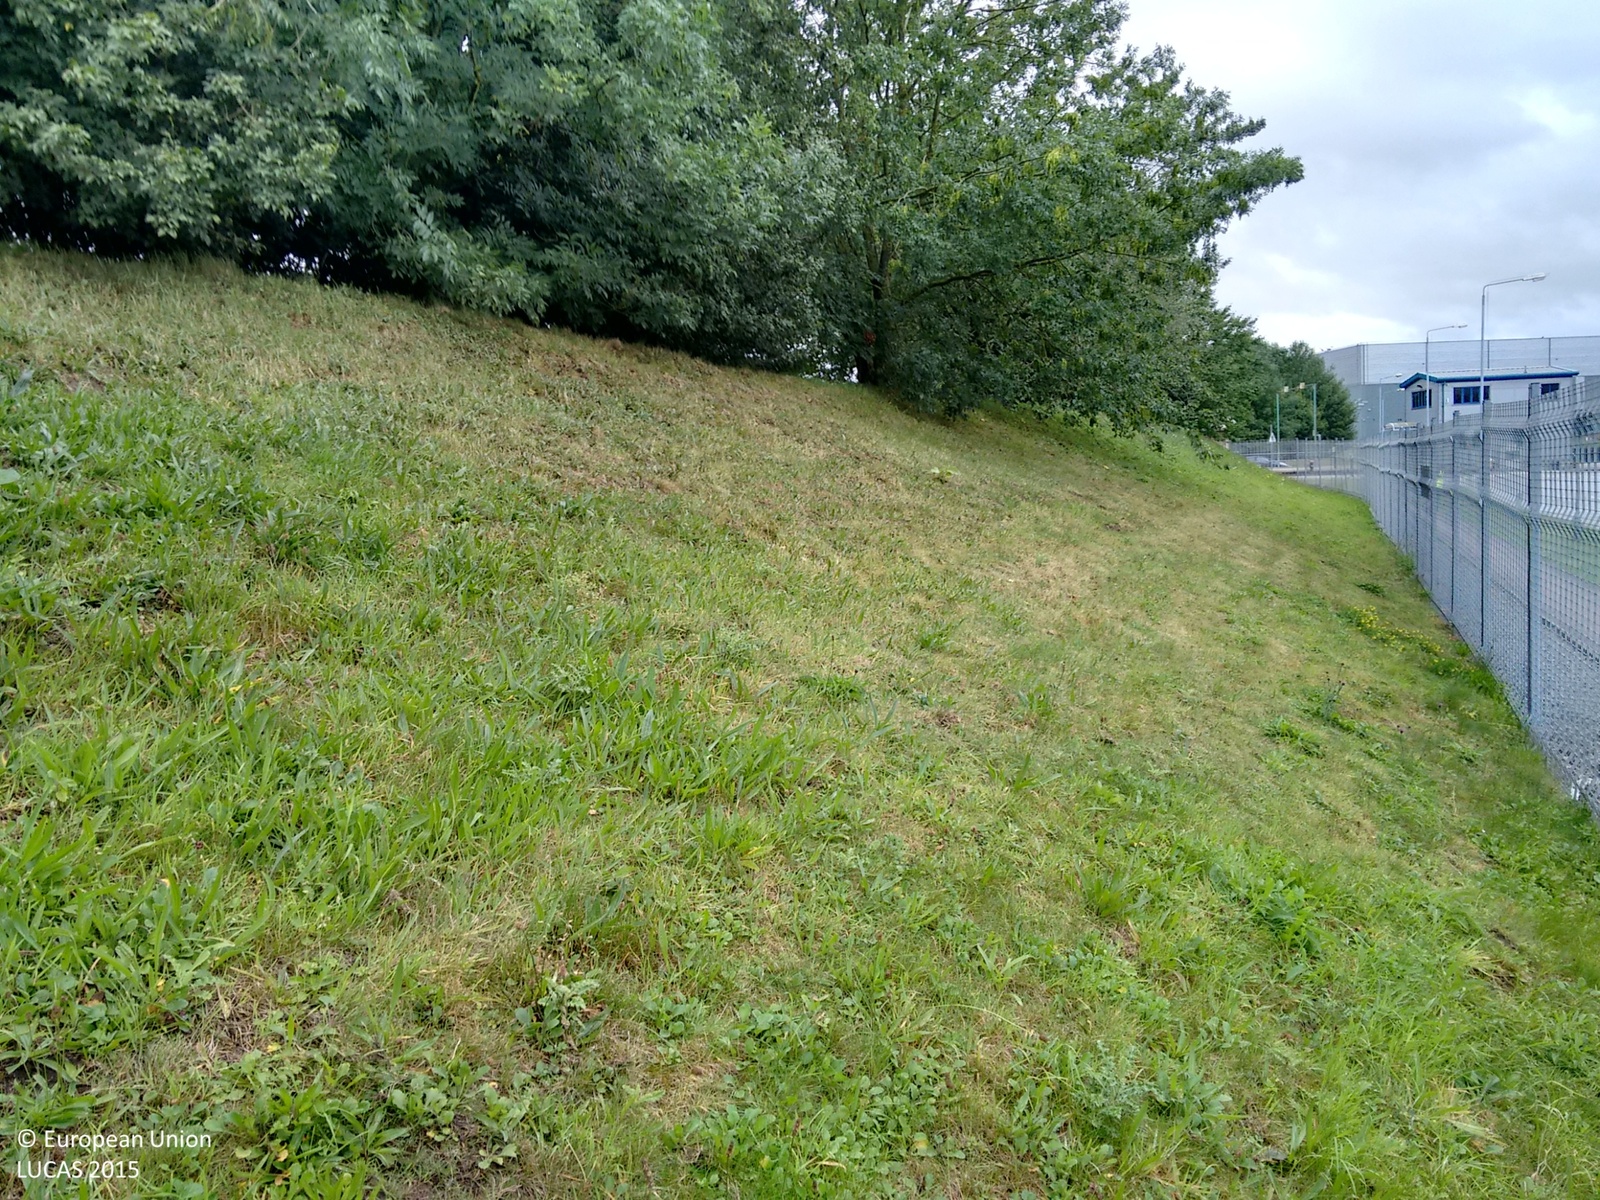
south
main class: Grassland
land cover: Grassland without tree/shrub cover
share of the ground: > 75 %
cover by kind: herbaceous plants 100 %
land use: Logistics and storage
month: August
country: GB
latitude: 52.7038
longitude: -1.3405
